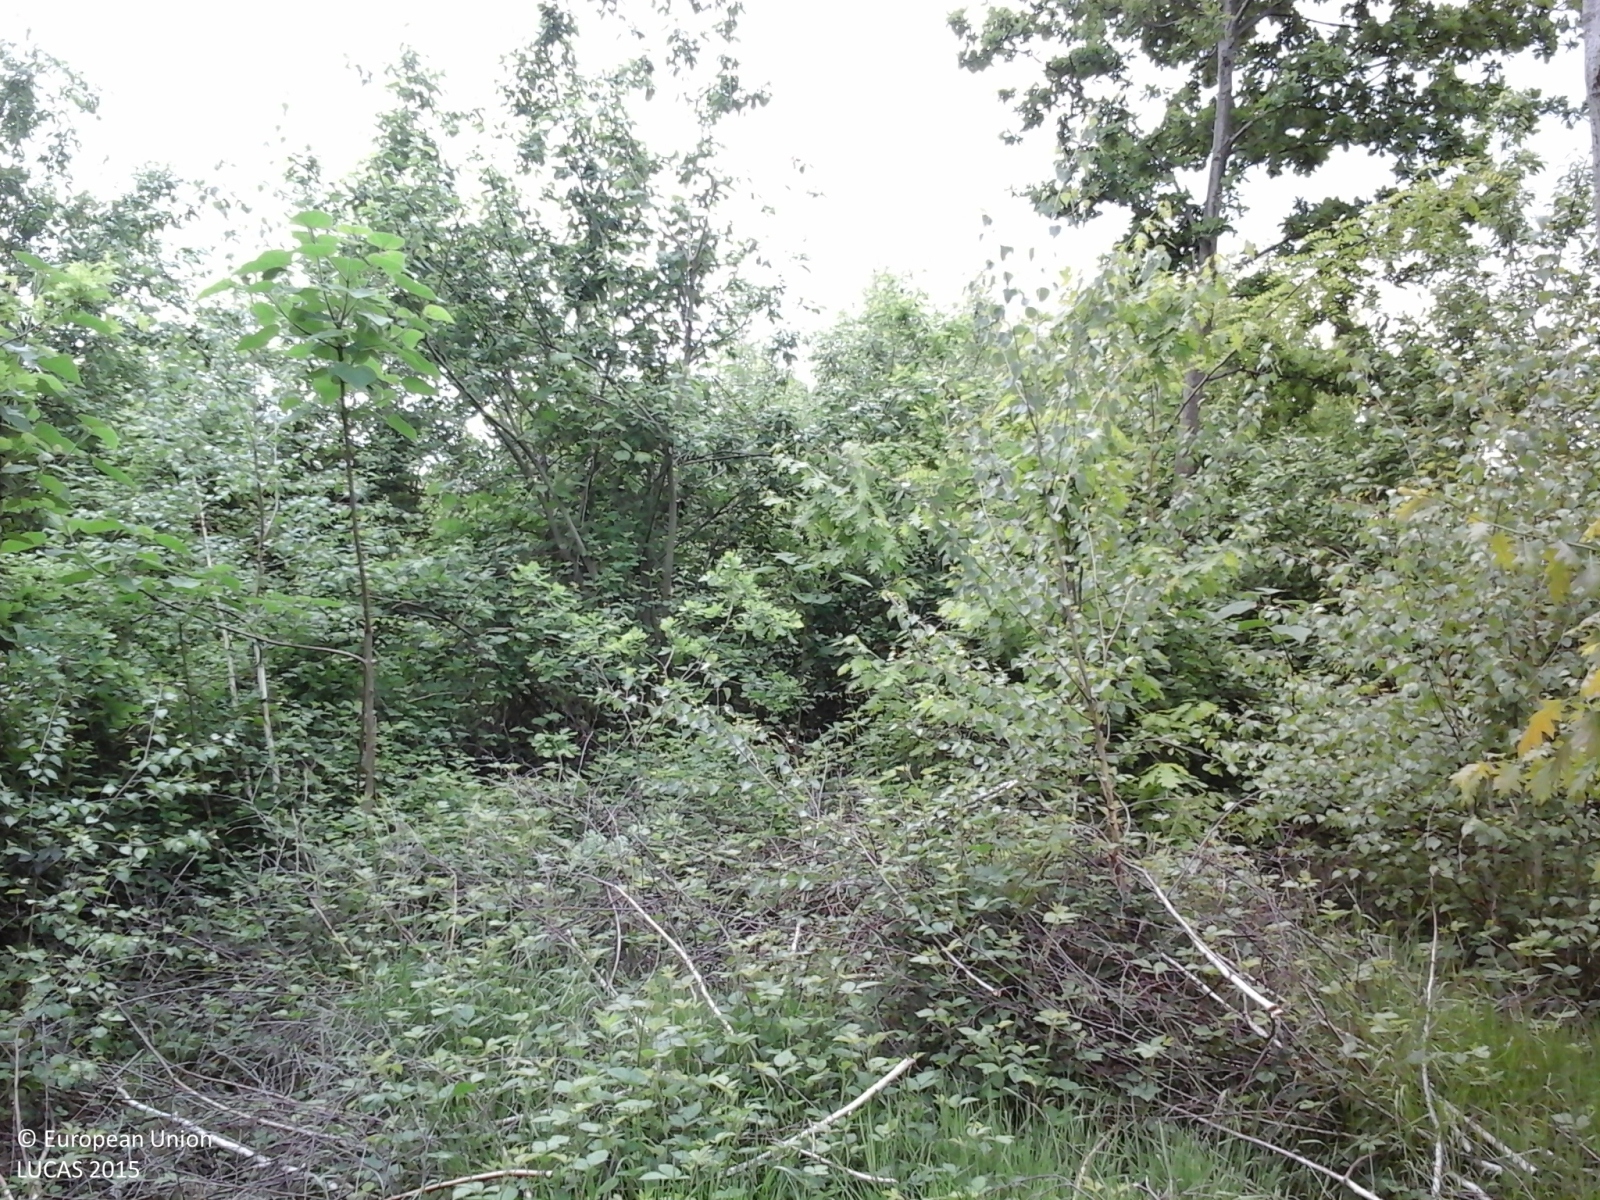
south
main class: Woodland
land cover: Broadleaved woodland
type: thermophilous deciduous forest
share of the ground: > 75 %
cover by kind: broadleaved forest trees 100 %
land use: Forestry
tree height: > 5 m
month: May
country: IT
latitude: 45.5839
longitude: 8.5029
